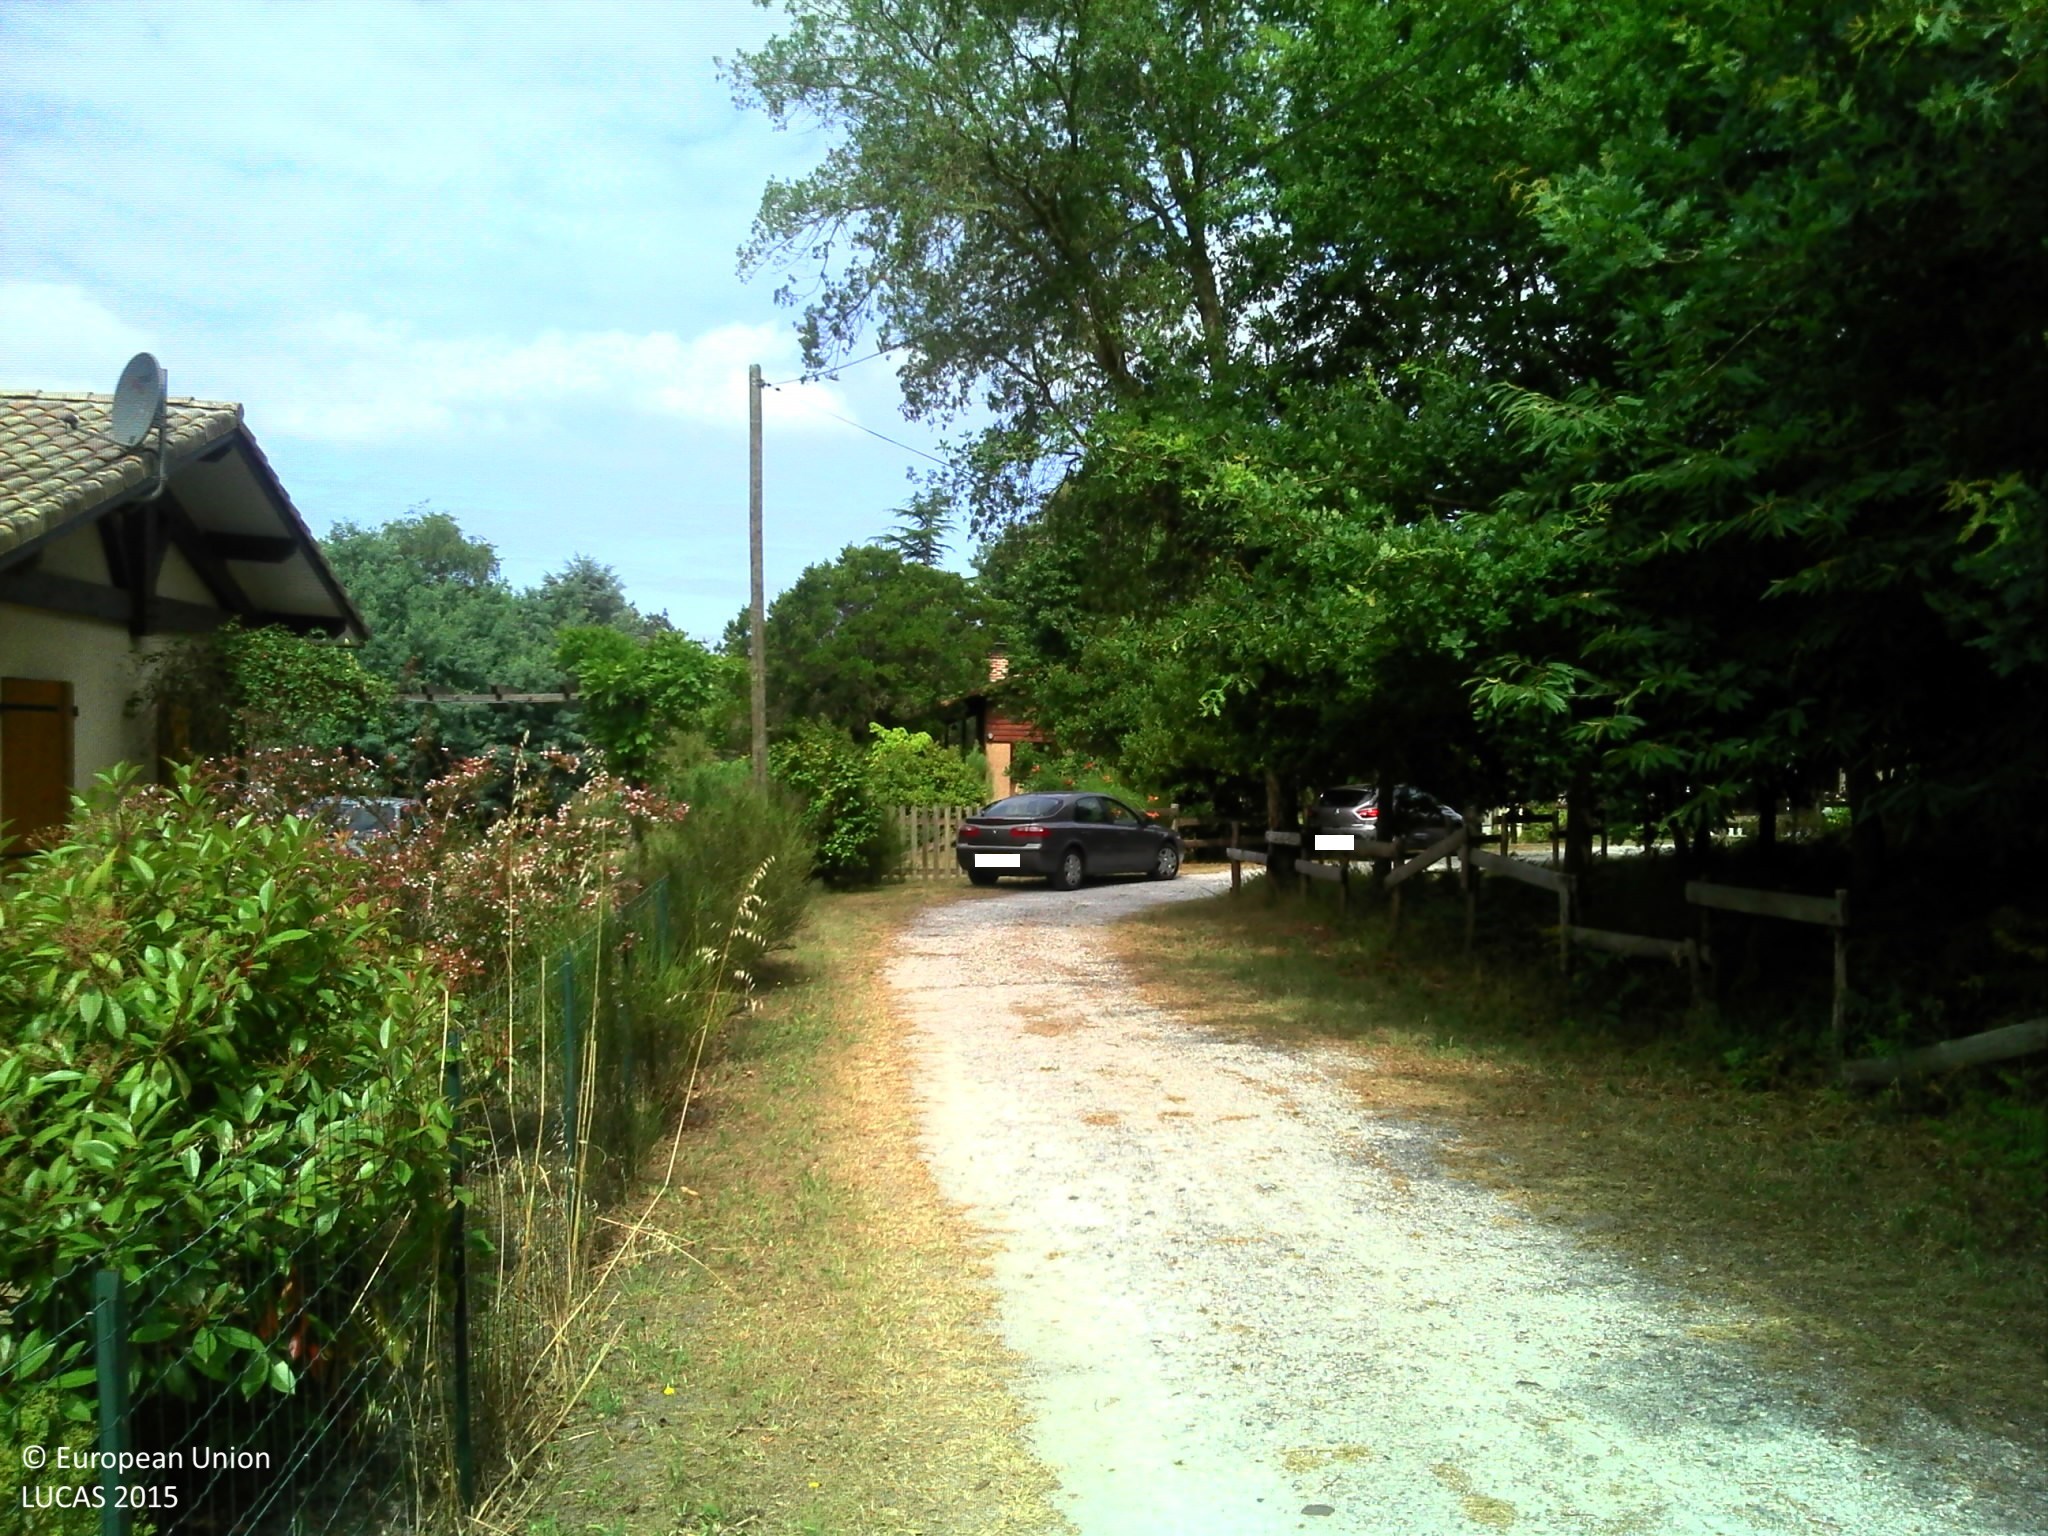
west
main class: Grassland
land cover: Grassland without tree/shrub cover
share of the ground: > 75 %
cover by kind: herbaceous plants 100 %
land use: Residential
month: July
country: FR
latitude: 43.8761
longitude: -1.3070
